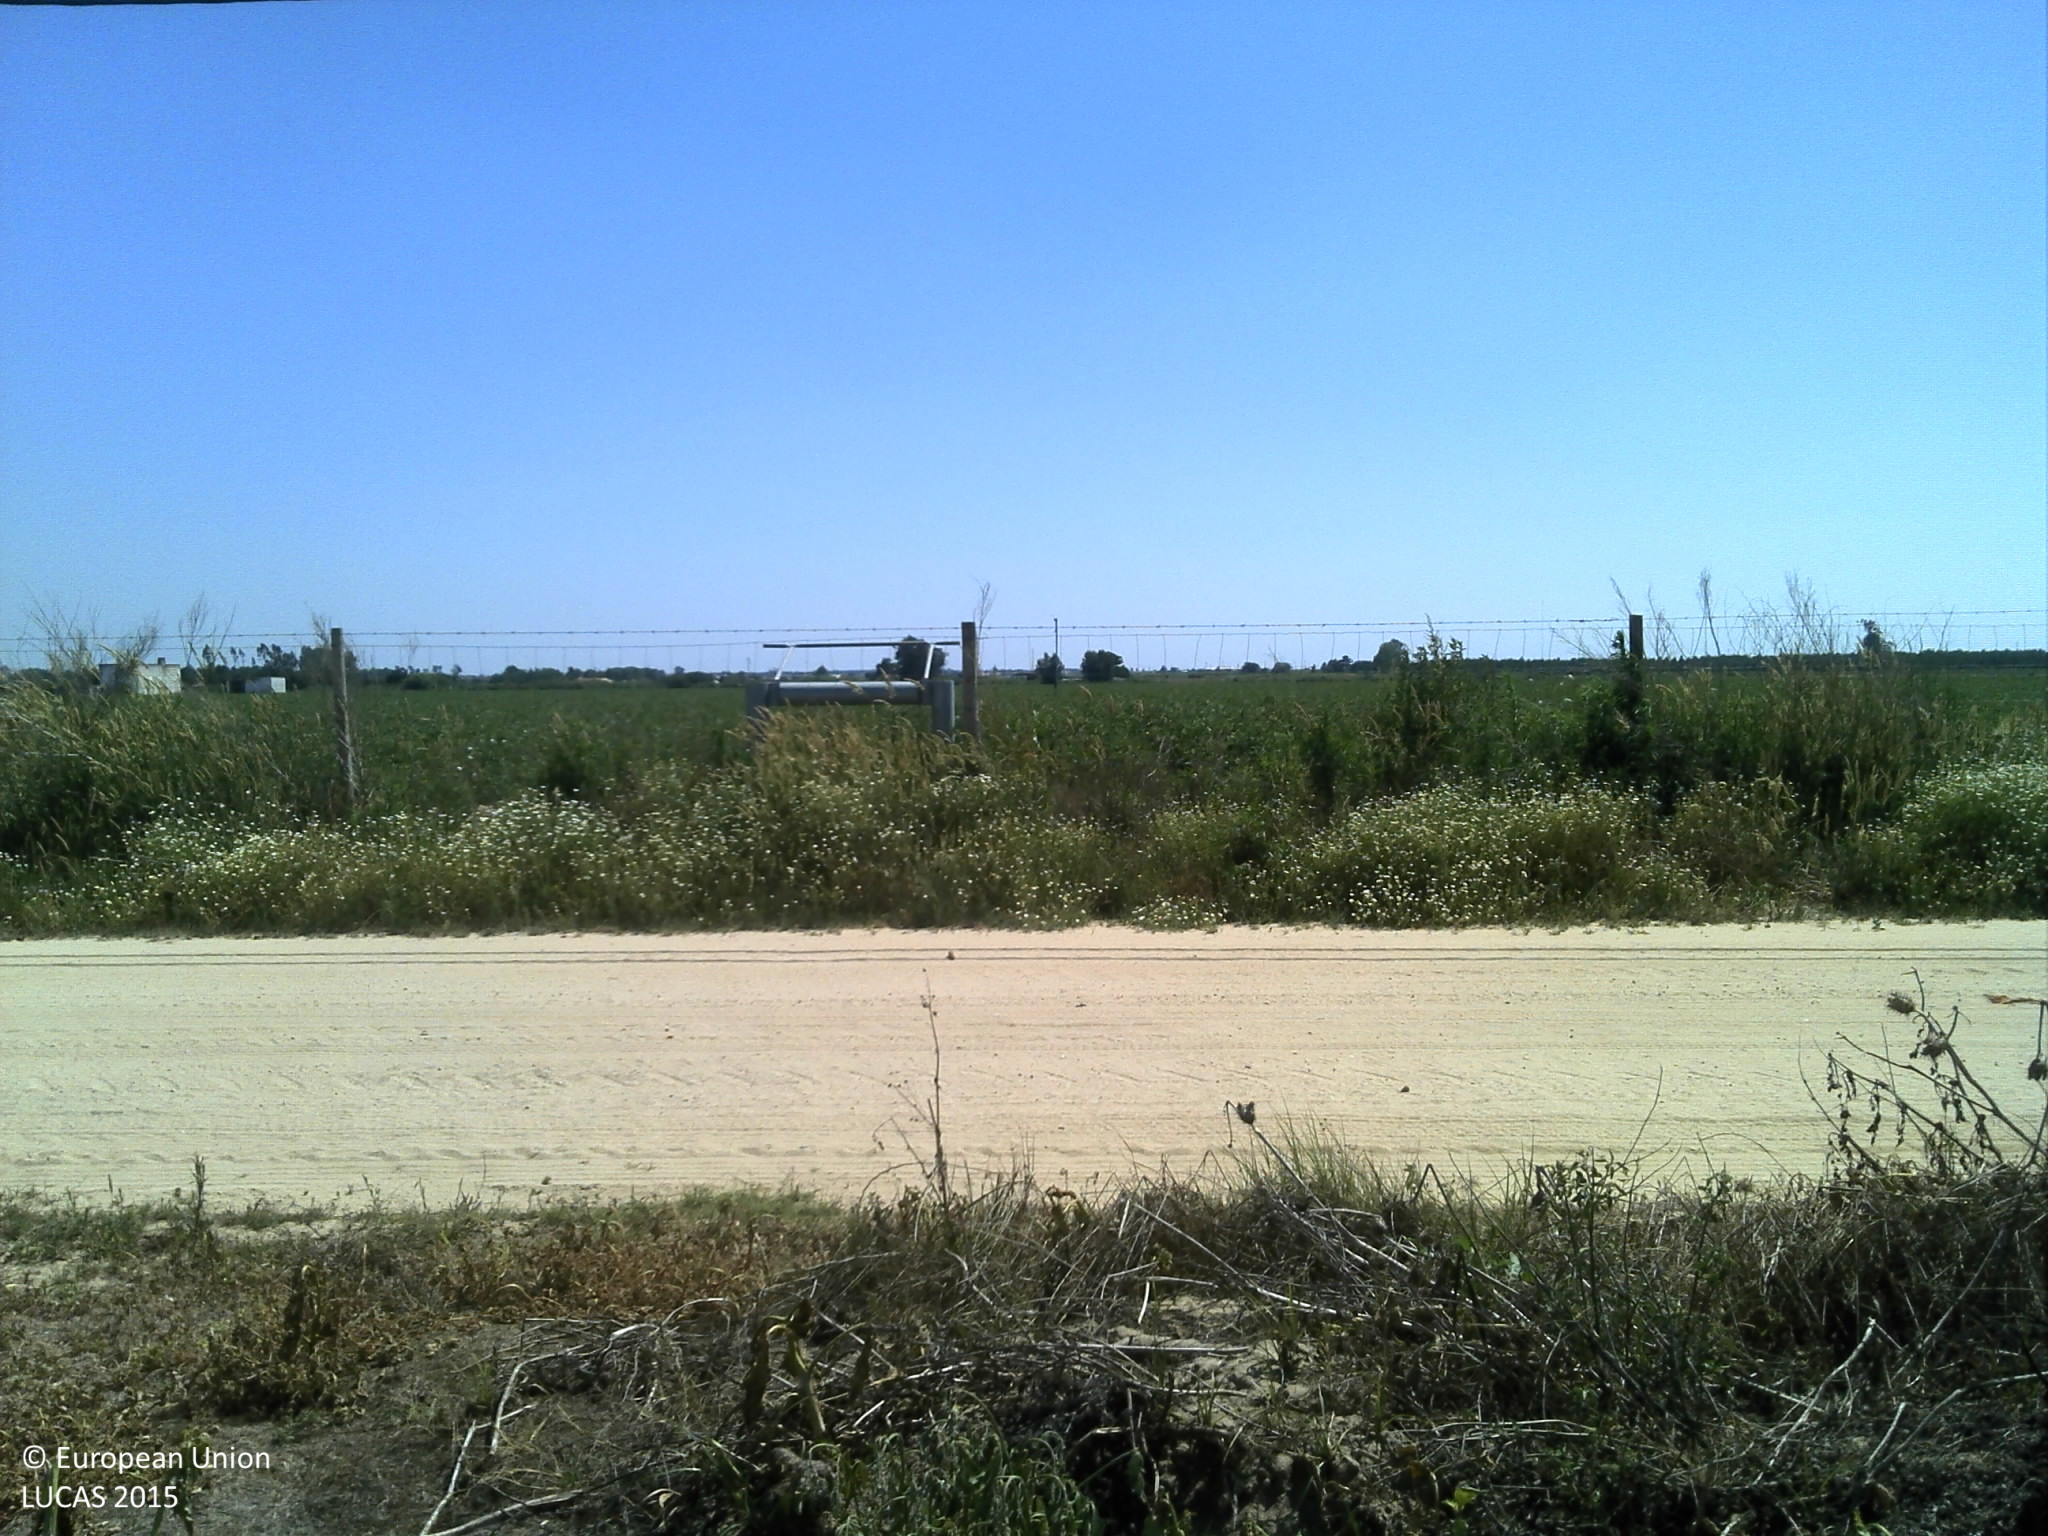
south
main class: Cropland
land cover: Nurseries
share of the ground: > 75 %
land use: Agriculture (excluding fallow land and kitchen gardens)
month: June
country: PT
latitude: 39.1478
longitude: -8.6408
